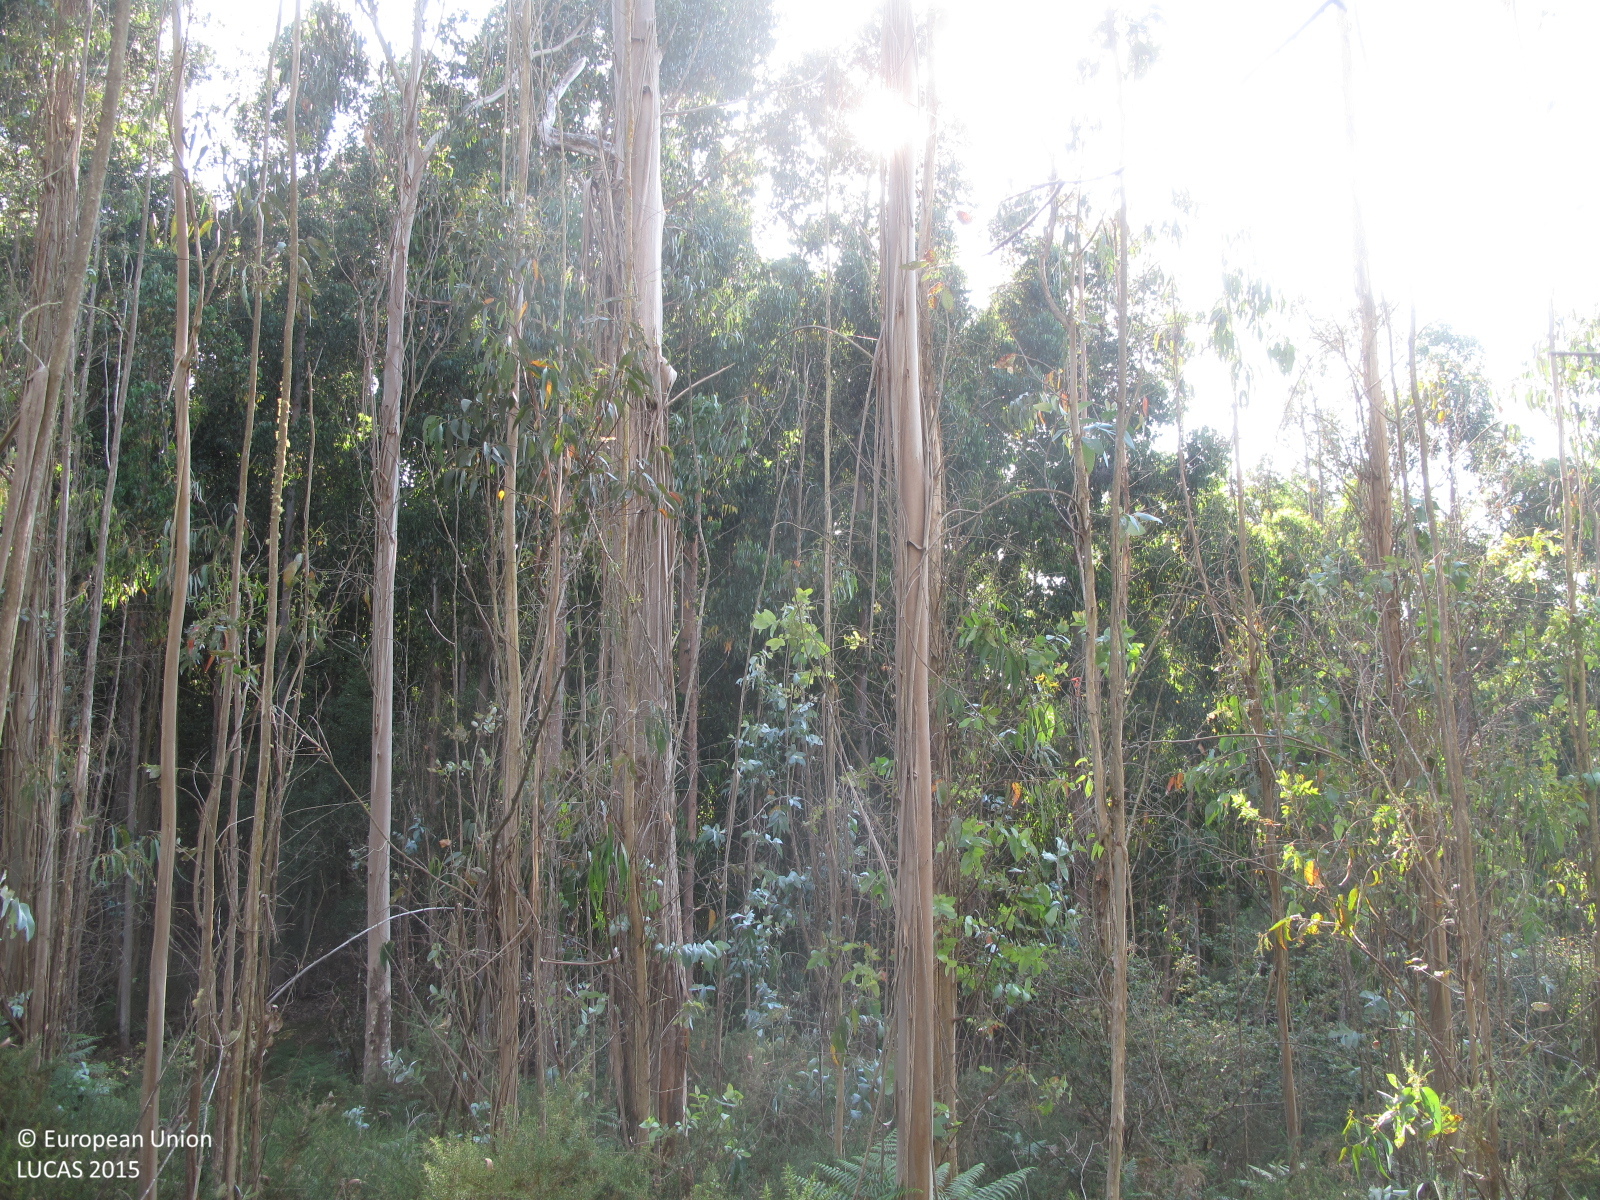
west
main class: Woodland
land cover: Broadleaved woodland
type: exotic forest
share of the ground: 25 - 50 %
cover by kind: shrubs 60 %, broadleaved forest trees 30 %, herbaceous plants 10 %
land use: Forestry
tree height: > 5 m
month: July
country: ES
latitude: 43.3169
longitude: -8.0863
